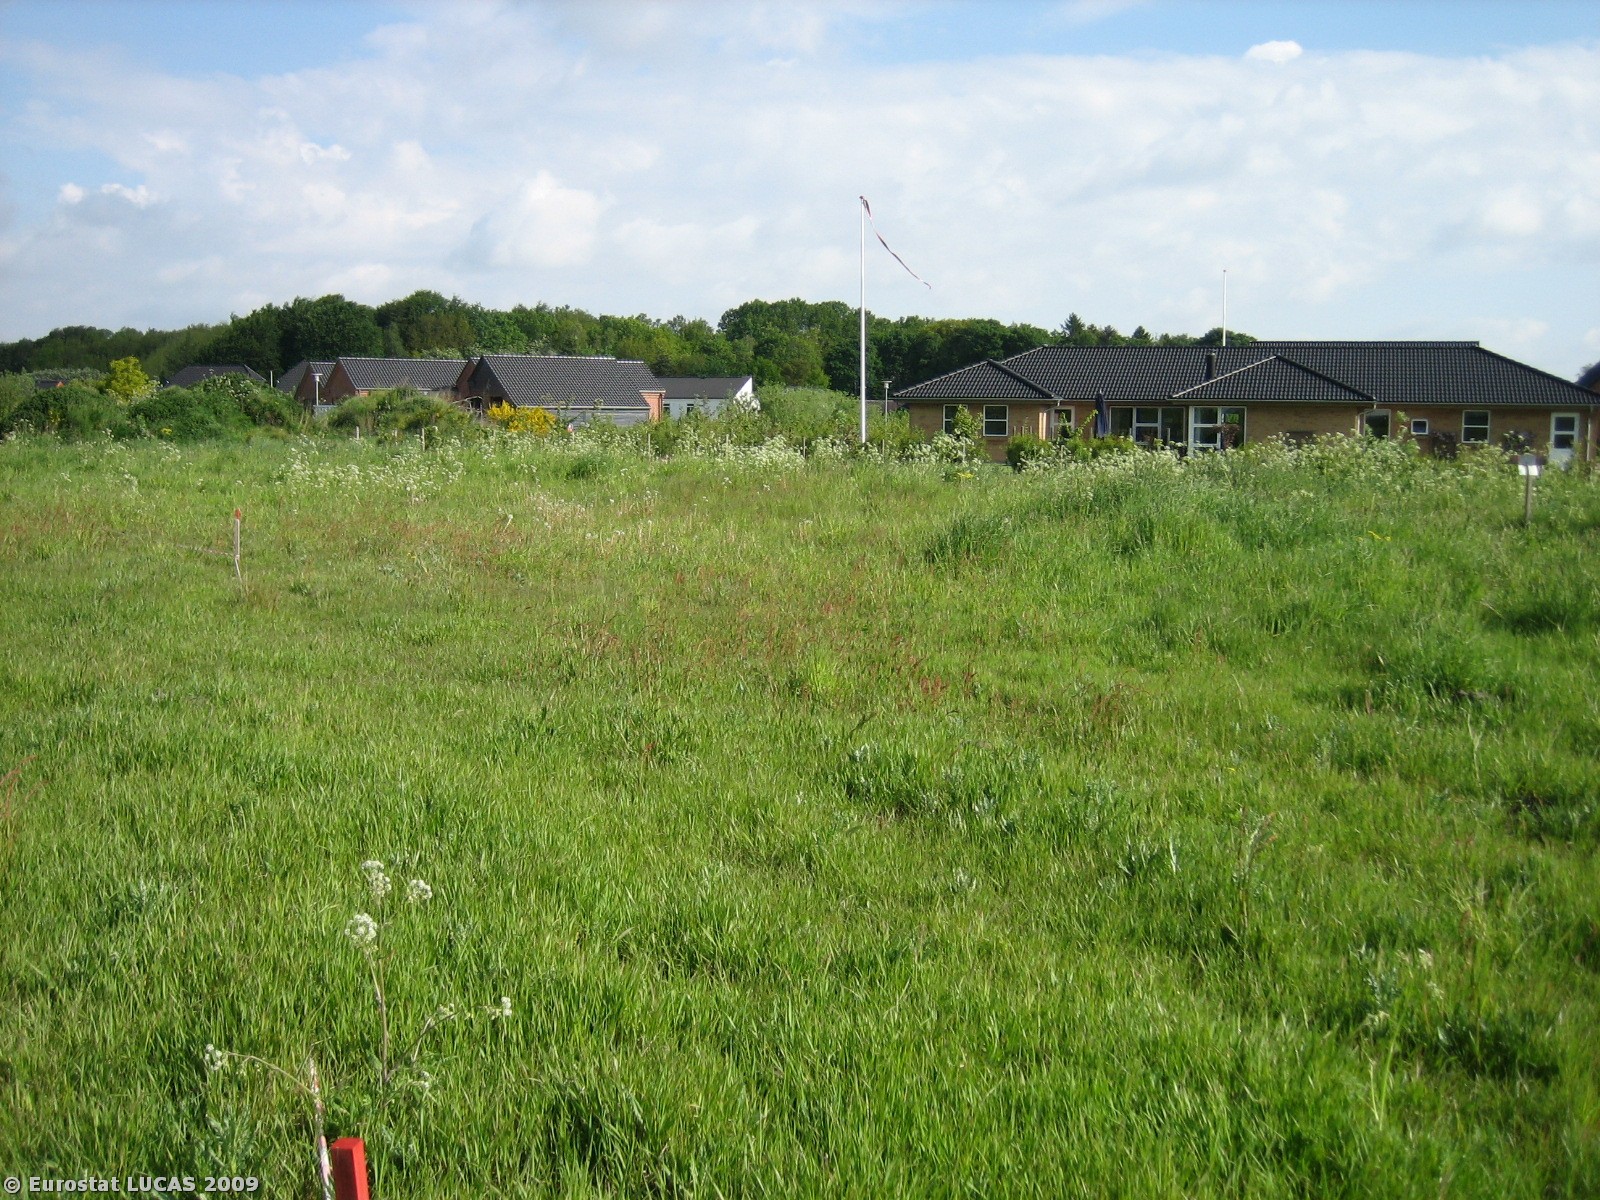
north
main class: Grassland
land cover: Grassland without tree/shrub cover
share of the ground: > 75 %
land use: Construction
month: May
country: DK
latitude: 56.1658
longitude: 8.9866
